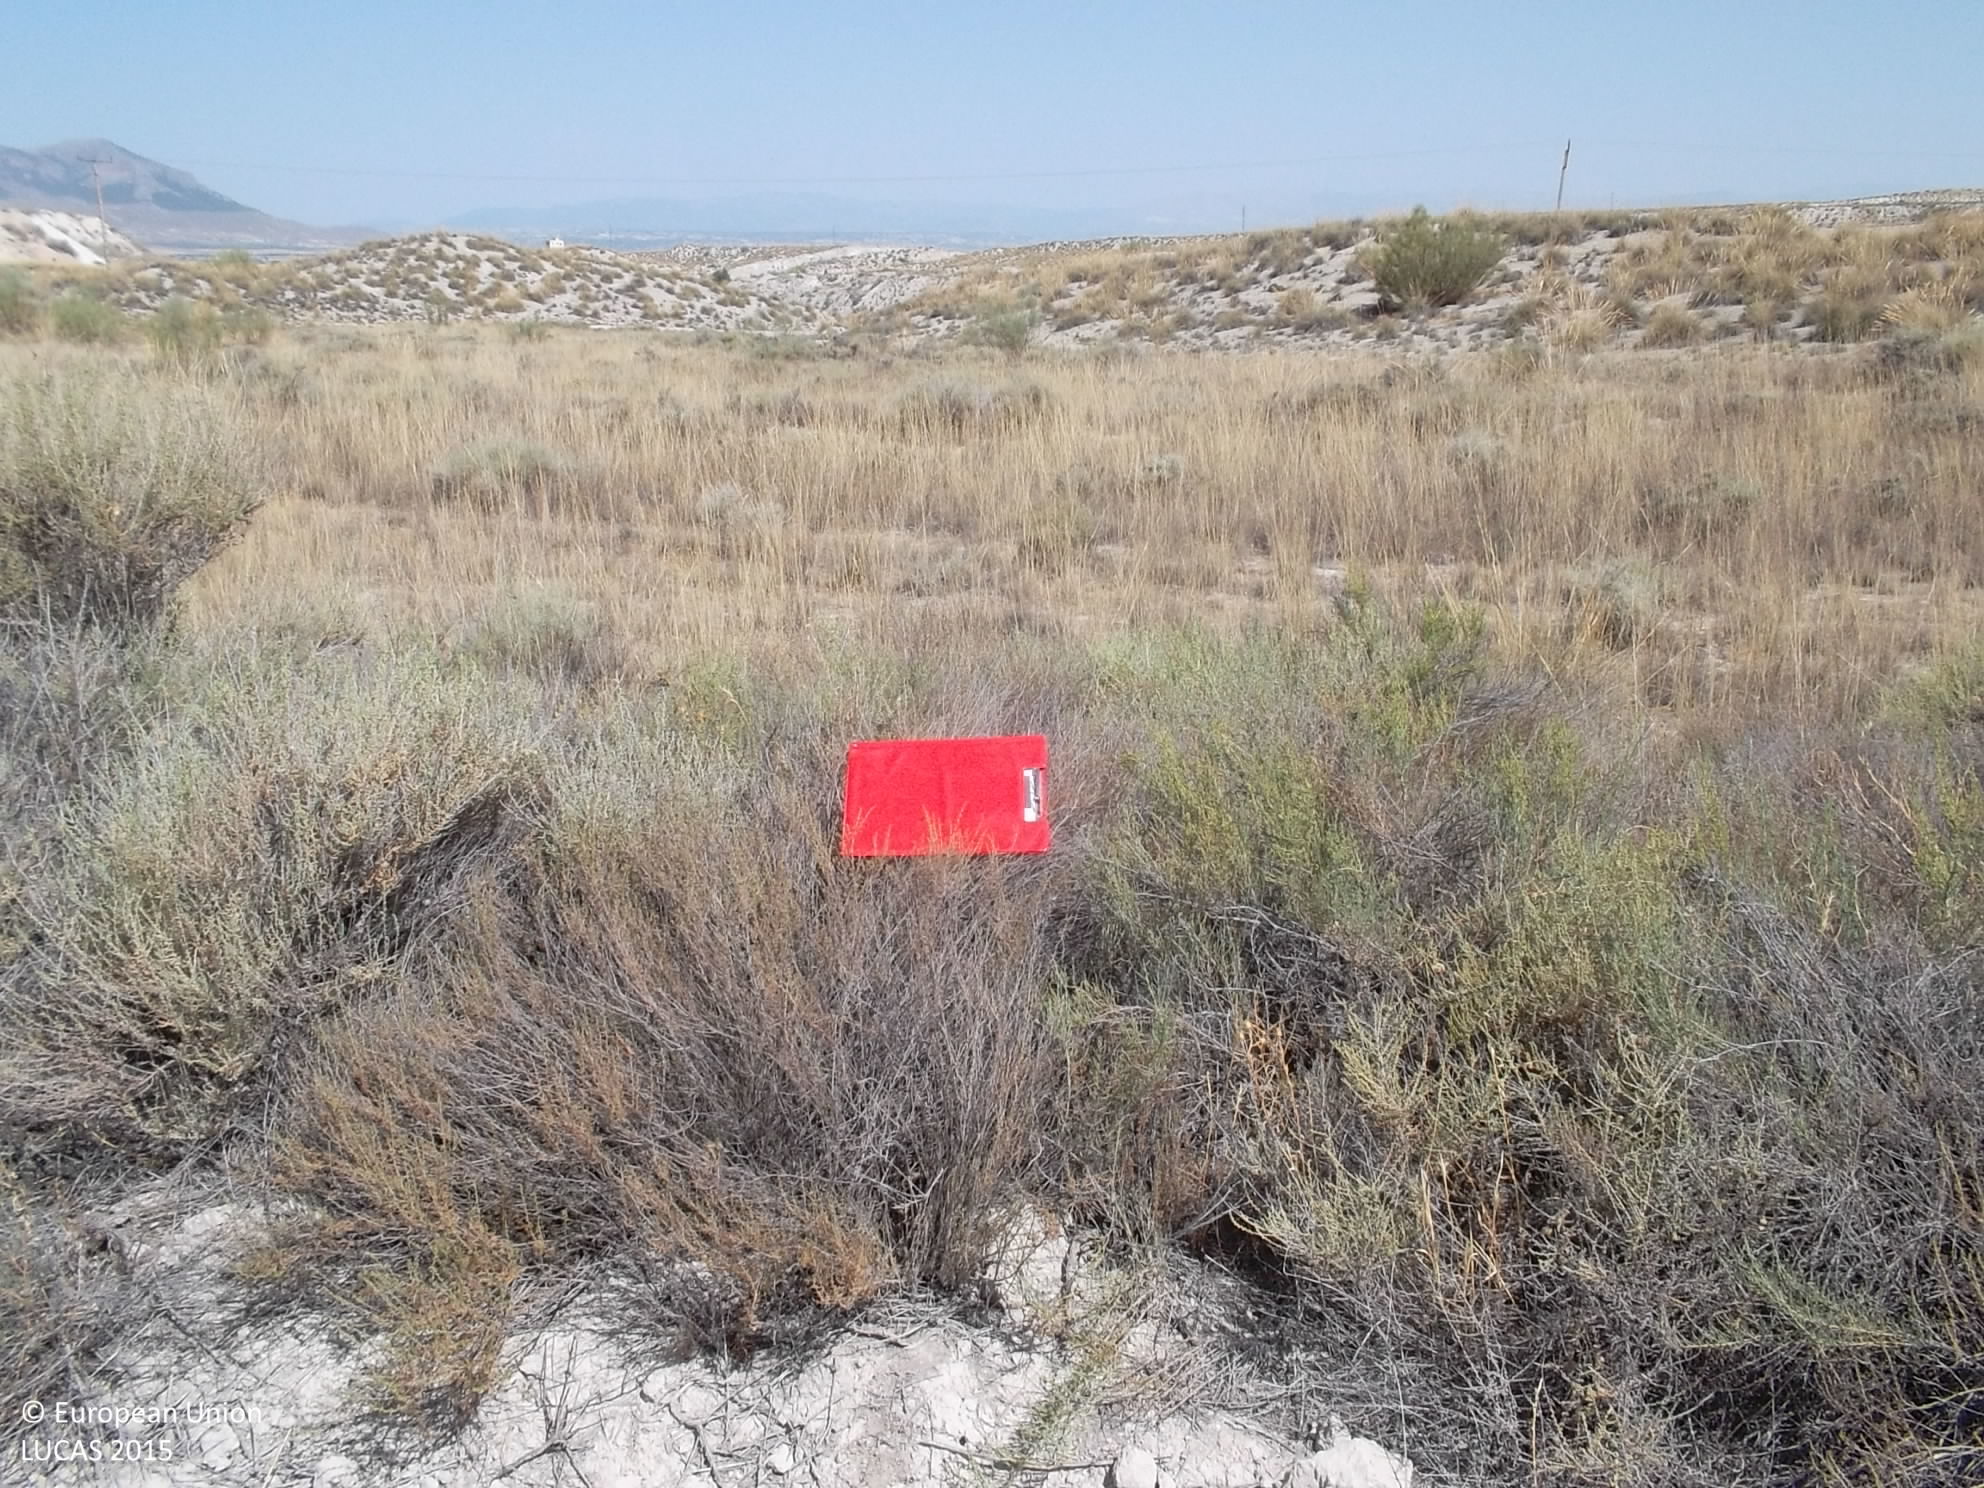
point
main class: Shrubland
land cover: Shrubland without tree cover
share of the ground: 10 - 25 %
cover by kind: herbaceous plants 80 %, shrubs 20 %
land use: Semi-natural and natural areas not in use
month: July
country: ES
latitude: 37.5167
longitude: -2.6925
